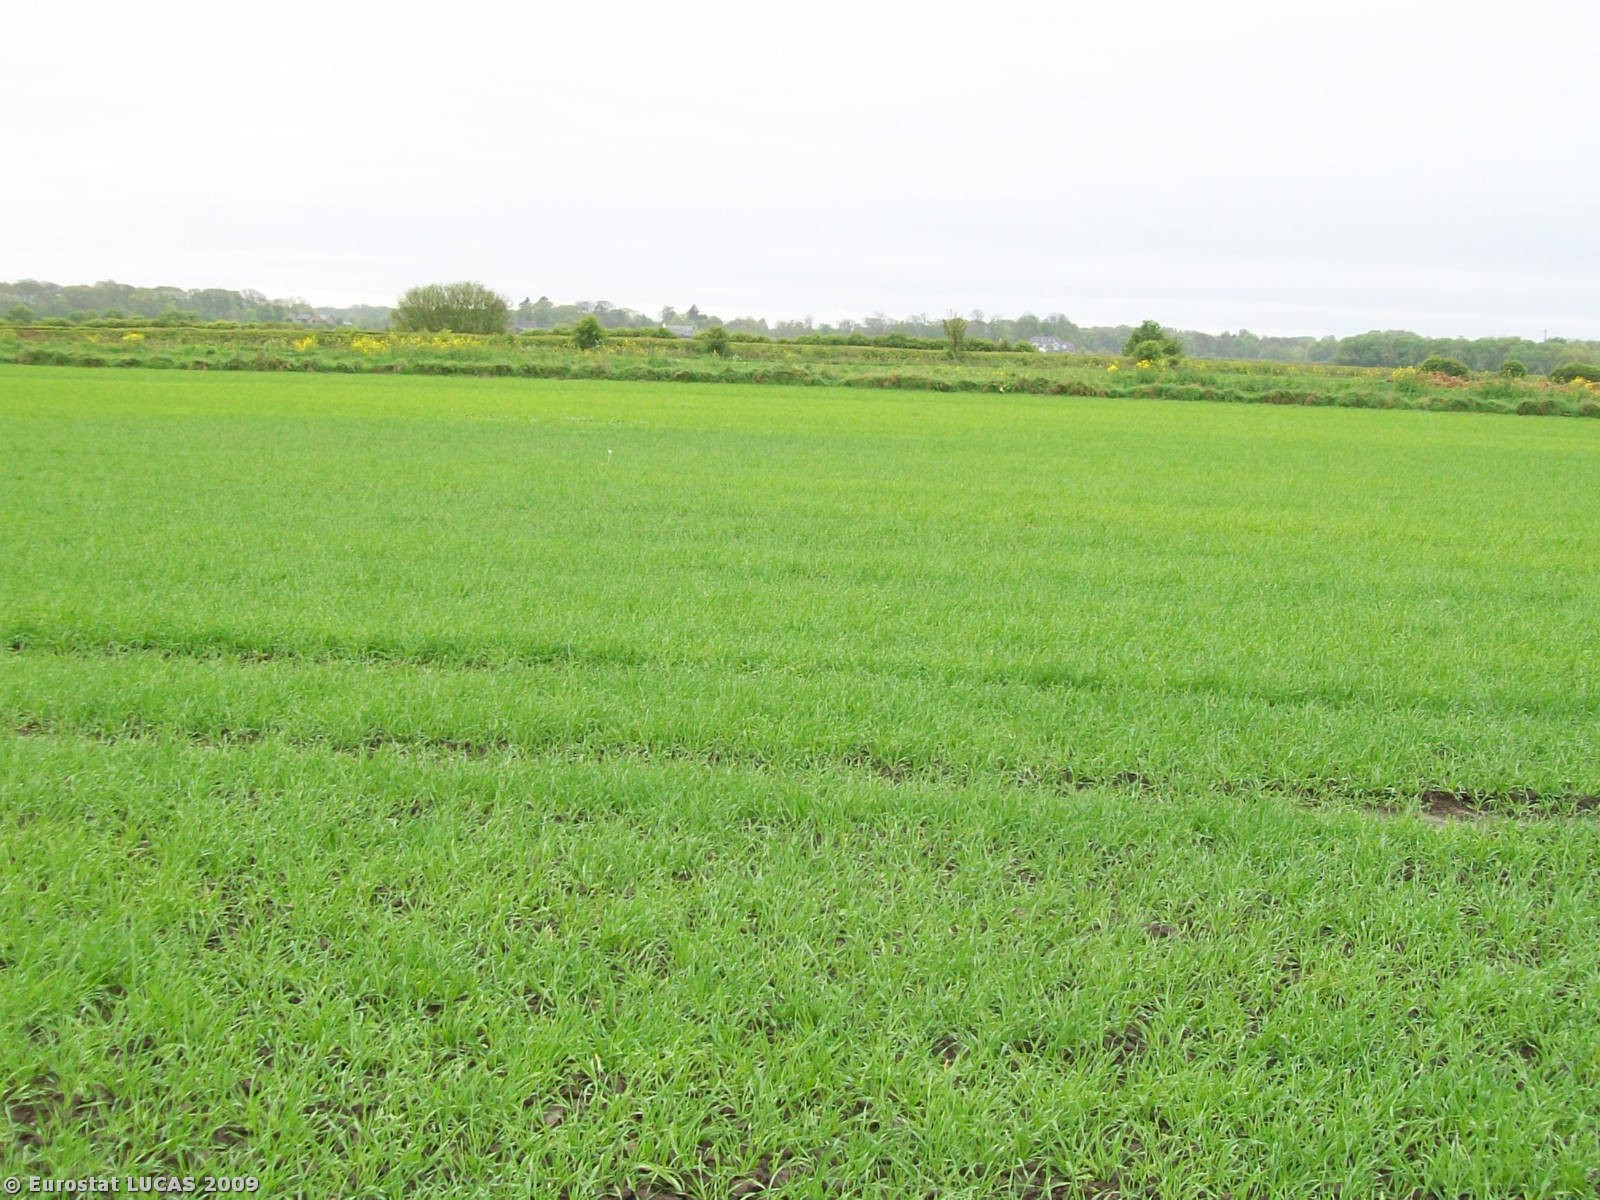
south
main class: Cropland
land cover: Barley
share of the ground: 50 - 75 %
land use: Agriculture (excluding fallow land and kitchen gardens)
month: May
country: GB
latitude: 53.7596
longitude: -2.9508
